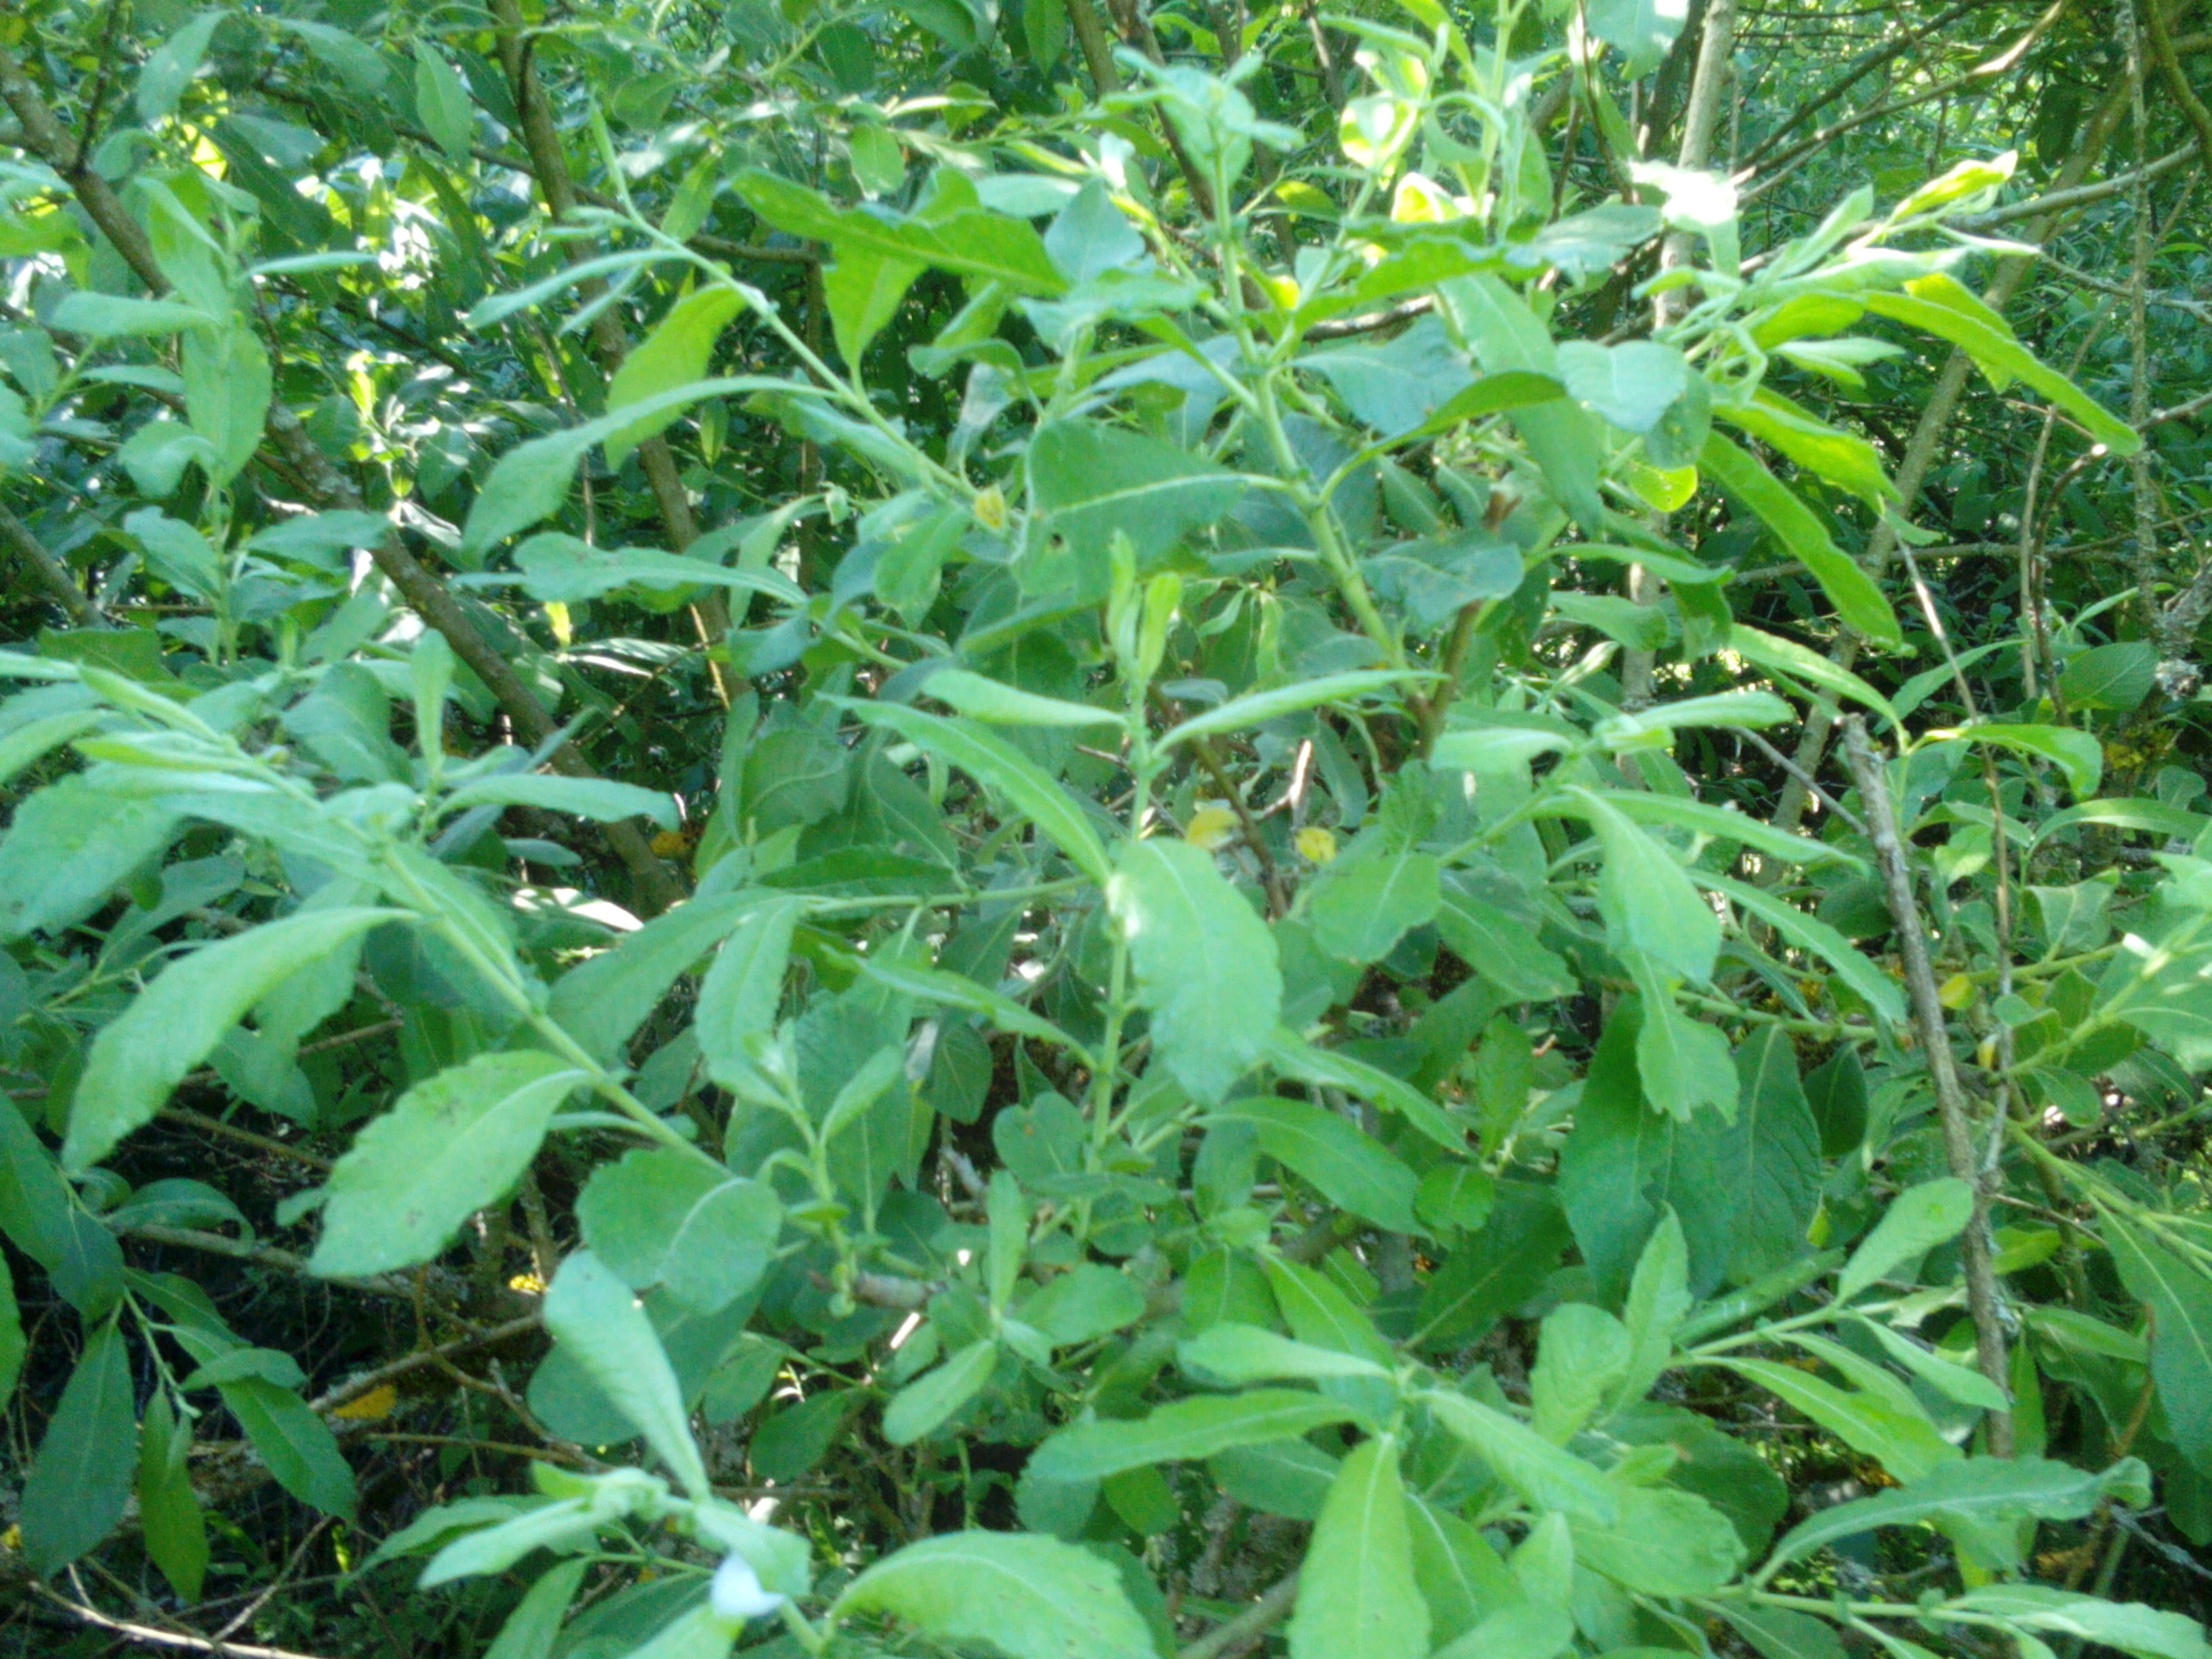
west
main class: Woodland
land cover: Broadleaved woodland
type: non-riverine alder, birch or aspen forest
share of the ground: > 75 %
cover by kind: broadleaved forest trees 65 %, coniferous forest trees 20 %, shrubs 10 %, herbaceous plants 5 %
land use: Forestry
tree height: > 5 m
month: June
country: LV
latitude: 56.5849
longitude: 22.2148
